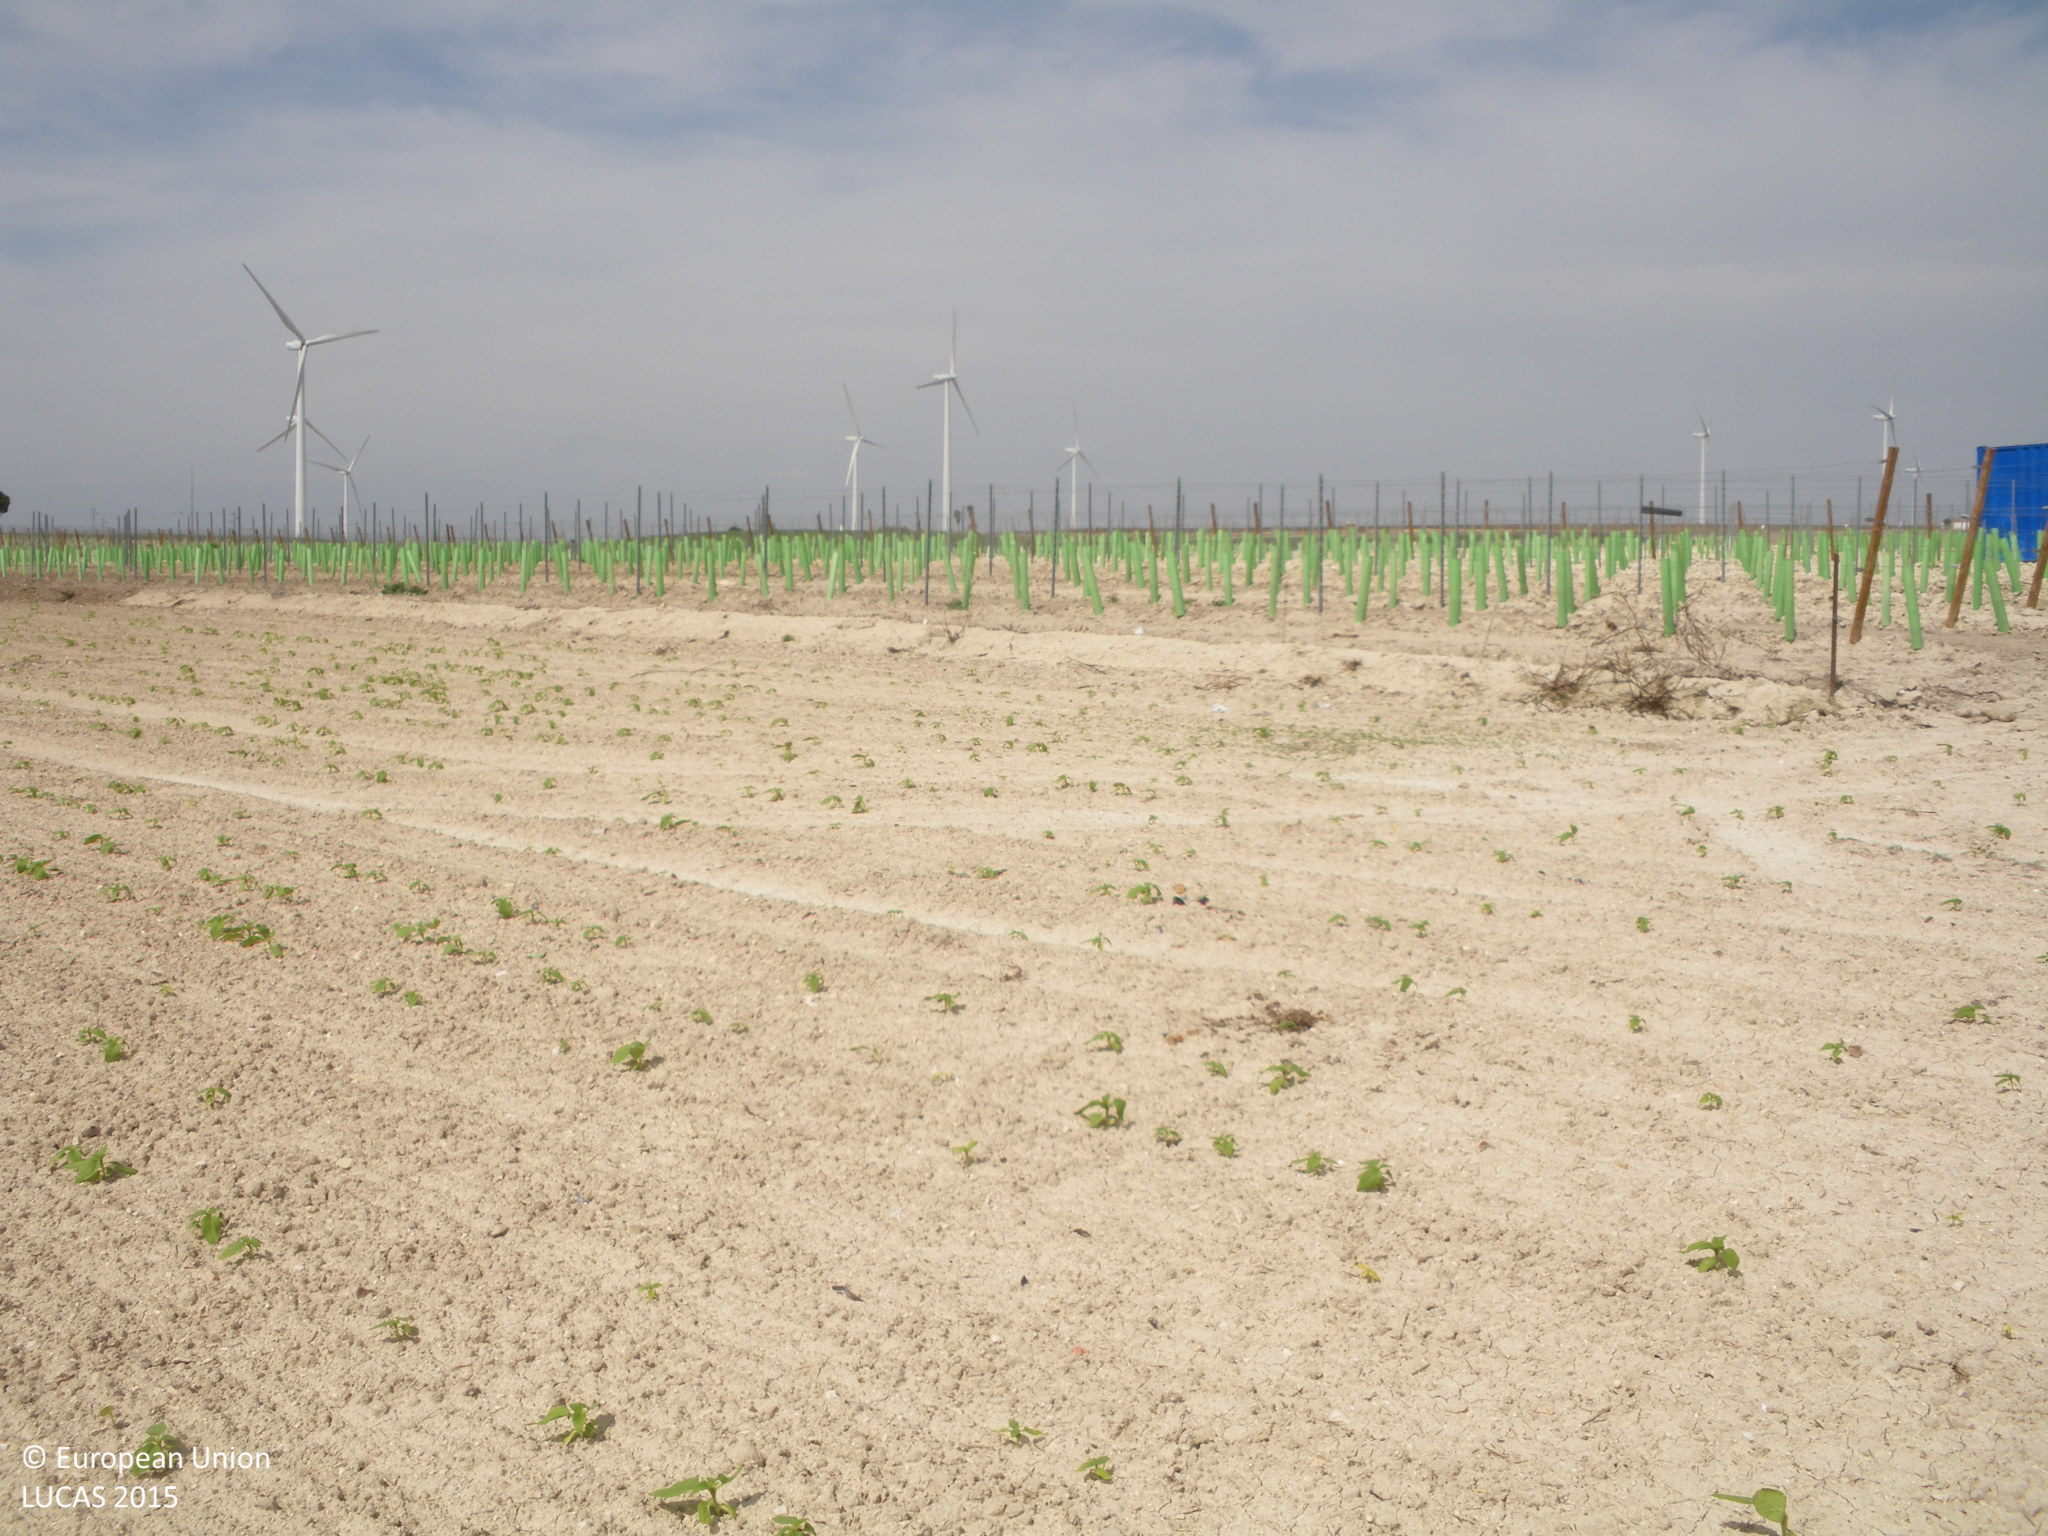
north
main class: Cropland
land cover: Sunflower
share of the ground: < 10 %
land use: Agriculture (excluding fallow land and kitchen gardens)
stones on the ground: < 10 %
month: April
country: ES
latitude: 36.6758
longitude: -6.2274
